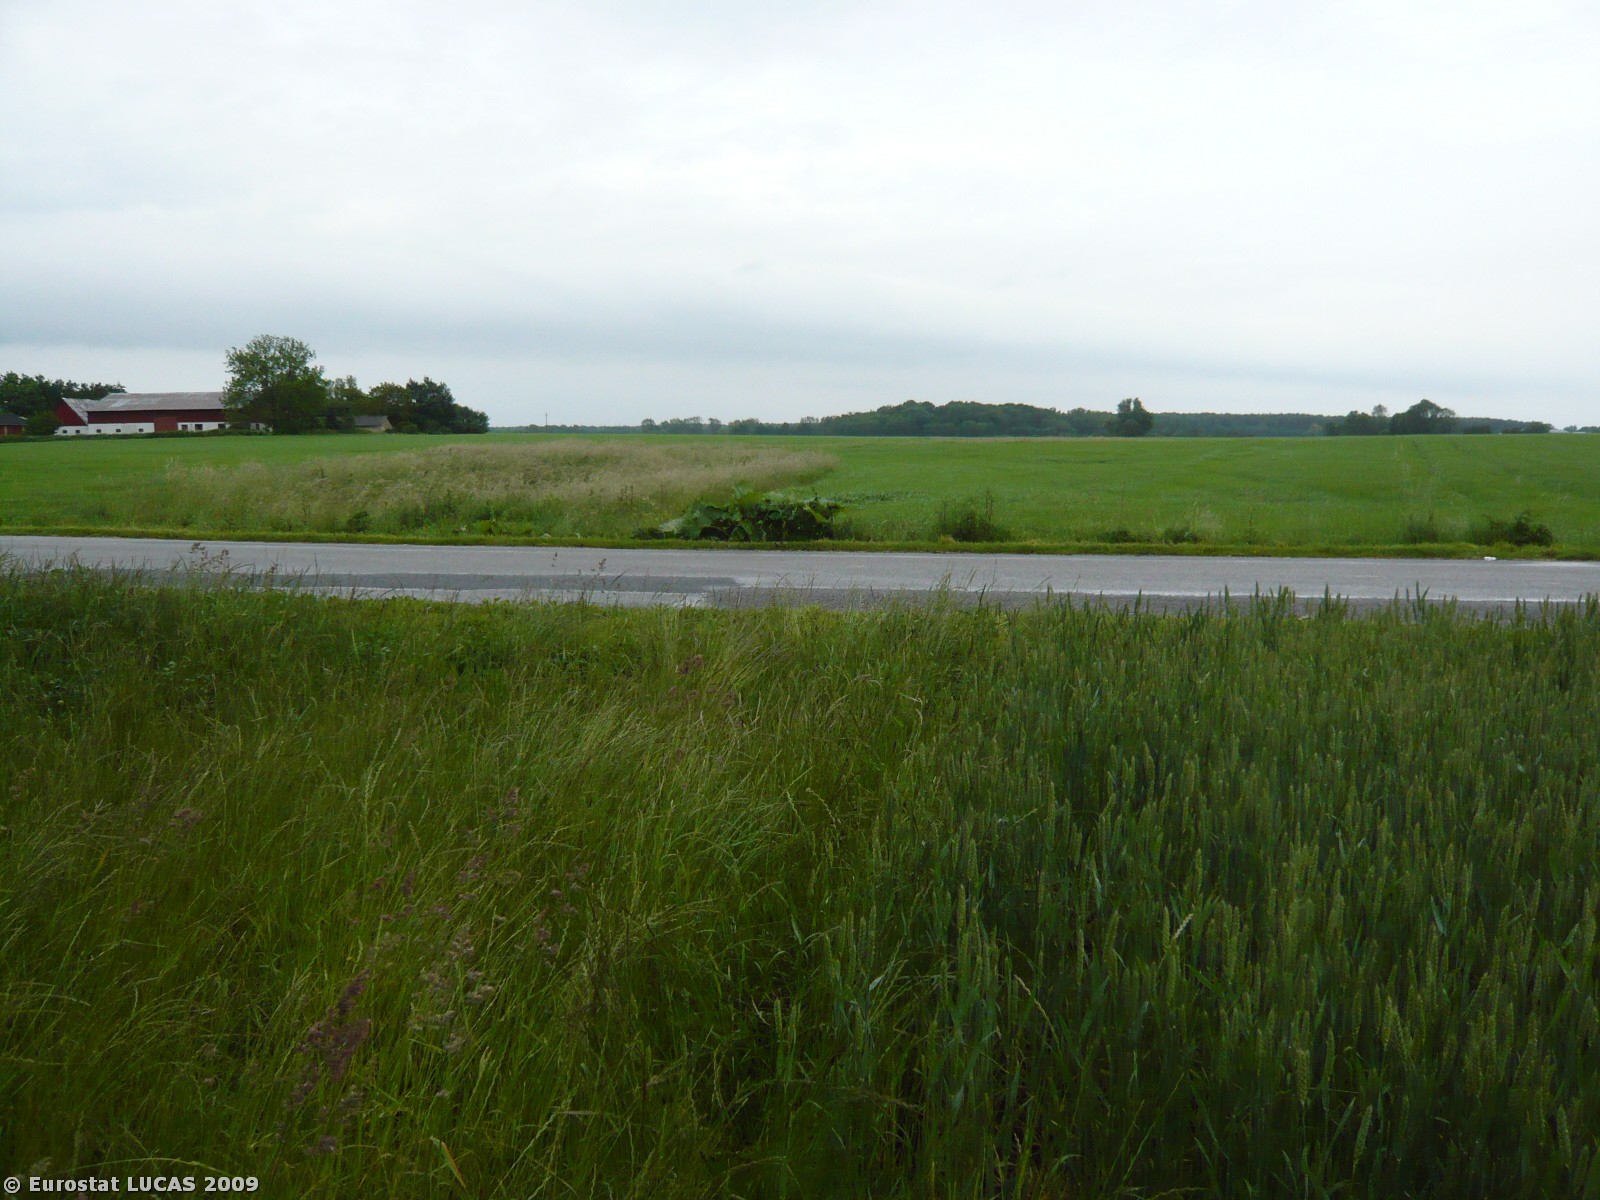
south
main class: Grassland
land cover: Grassland without tree/shrub cover
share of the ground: > 75 %
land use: Agriculture (excluding fallow land and kitchen gardens)
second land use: Road transport
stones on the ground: < 10 %
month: June
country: DK
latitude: 54.7555
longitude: 11.7547
